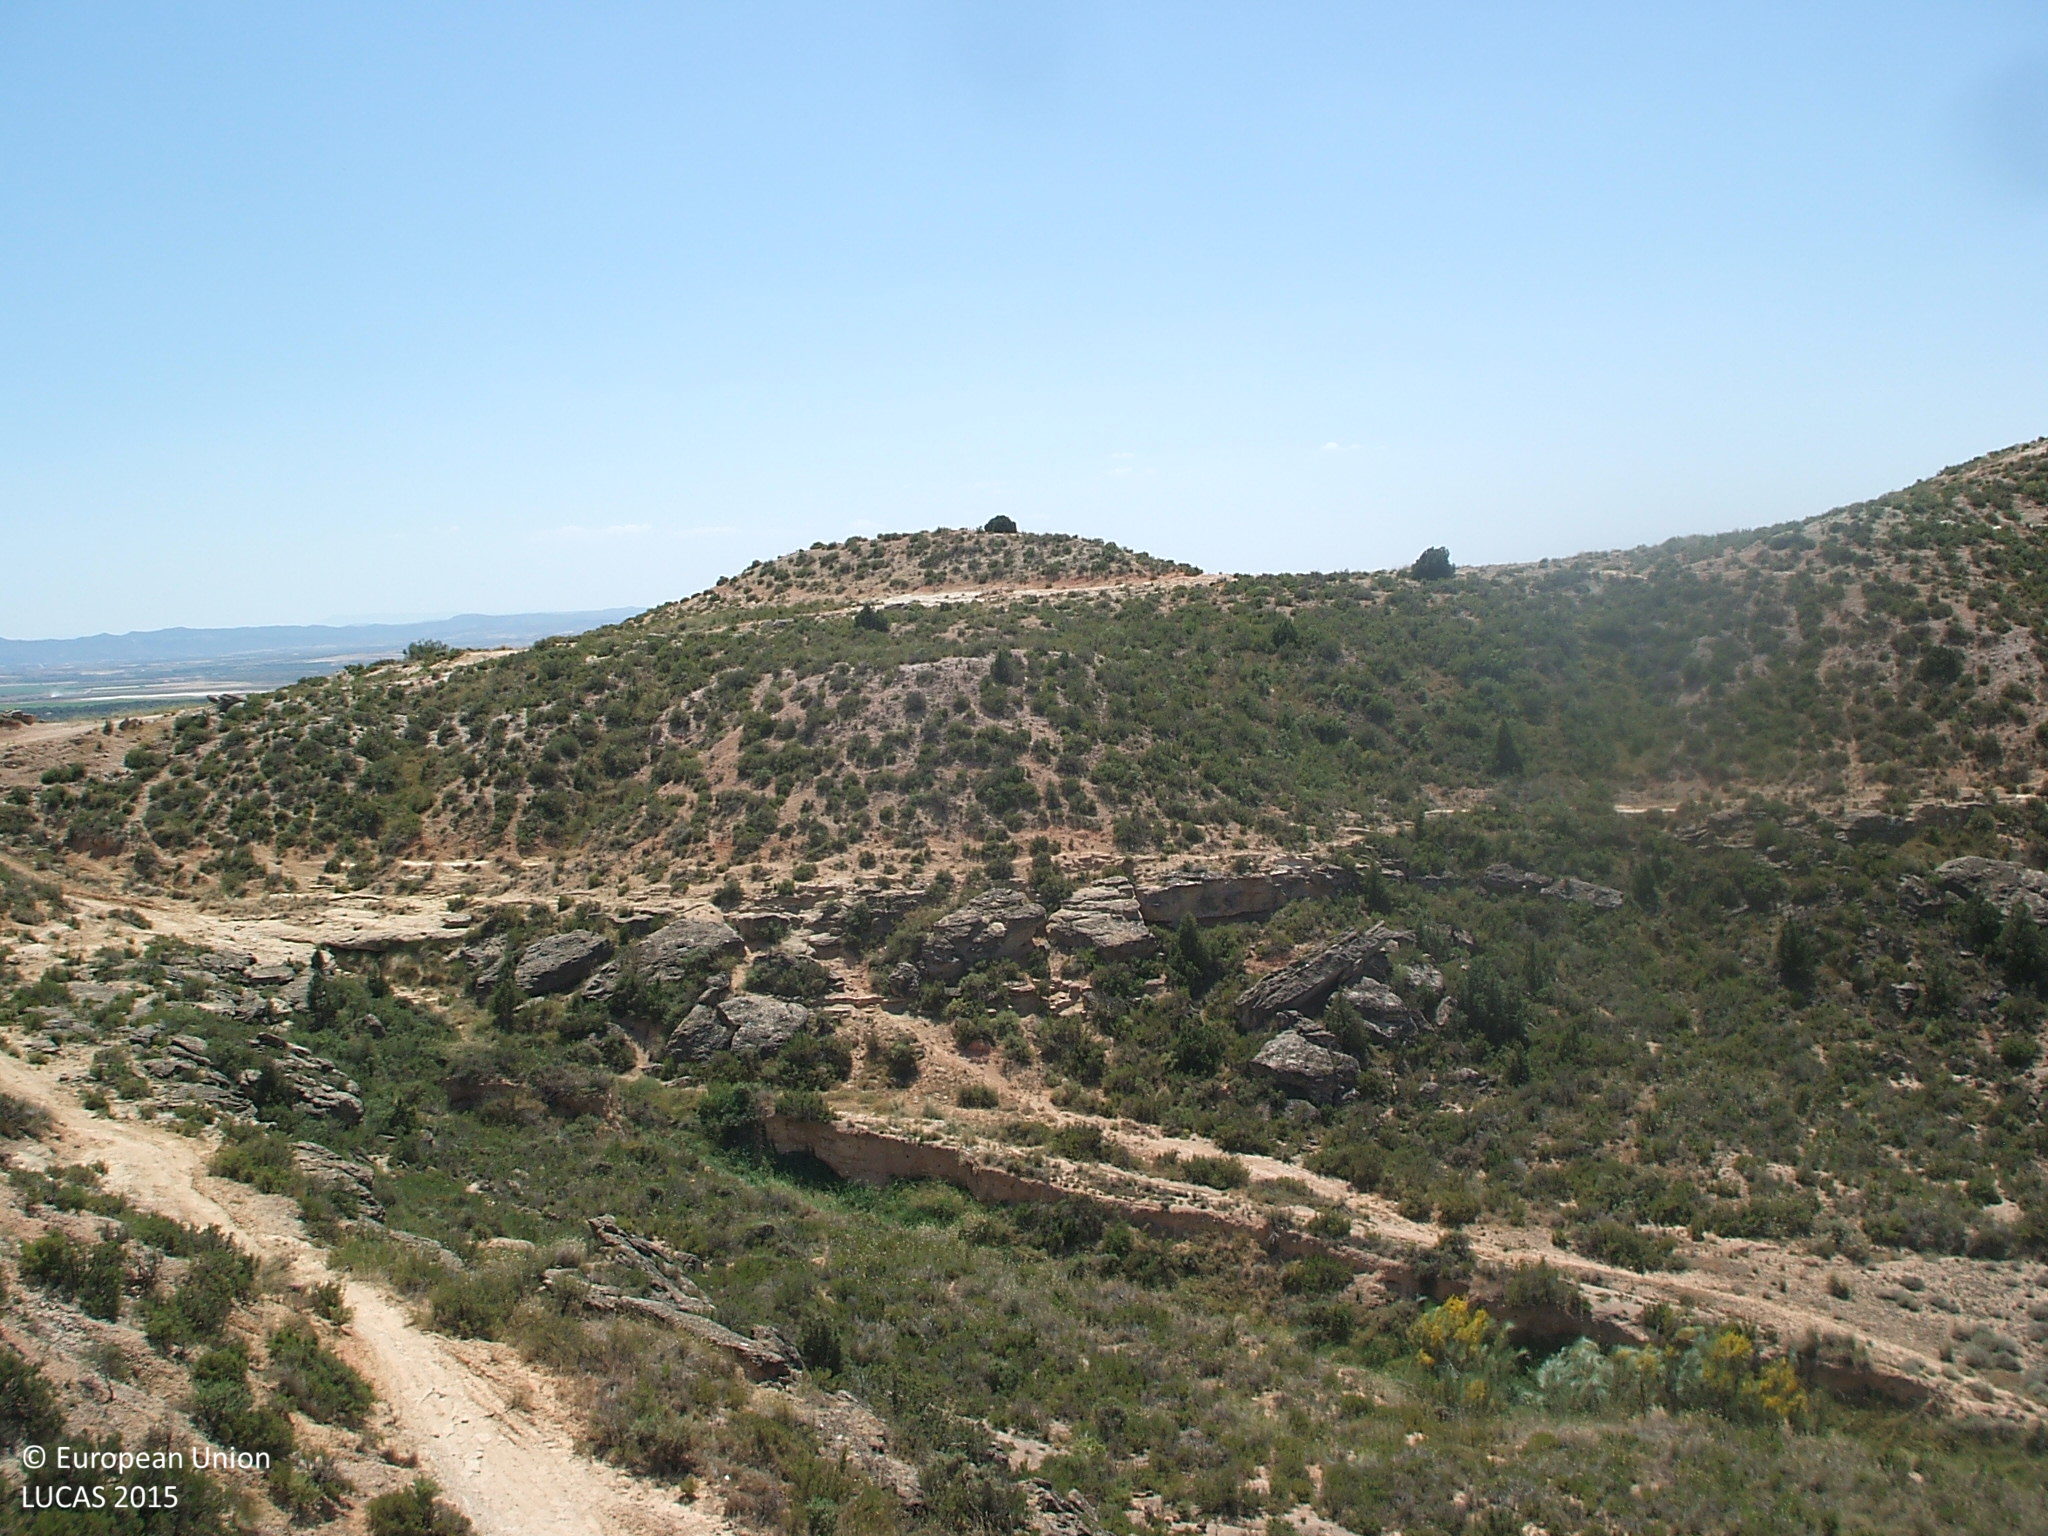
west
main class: Shrubland
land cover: Shrubland without tree cover
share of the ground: 10 - 25 %
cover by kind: consolidated bare surface 80 %, shrubs 20 %
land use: Semi-natural and natural areas not in use
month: June
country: ES
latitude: 41.0834
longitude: -0.1895
